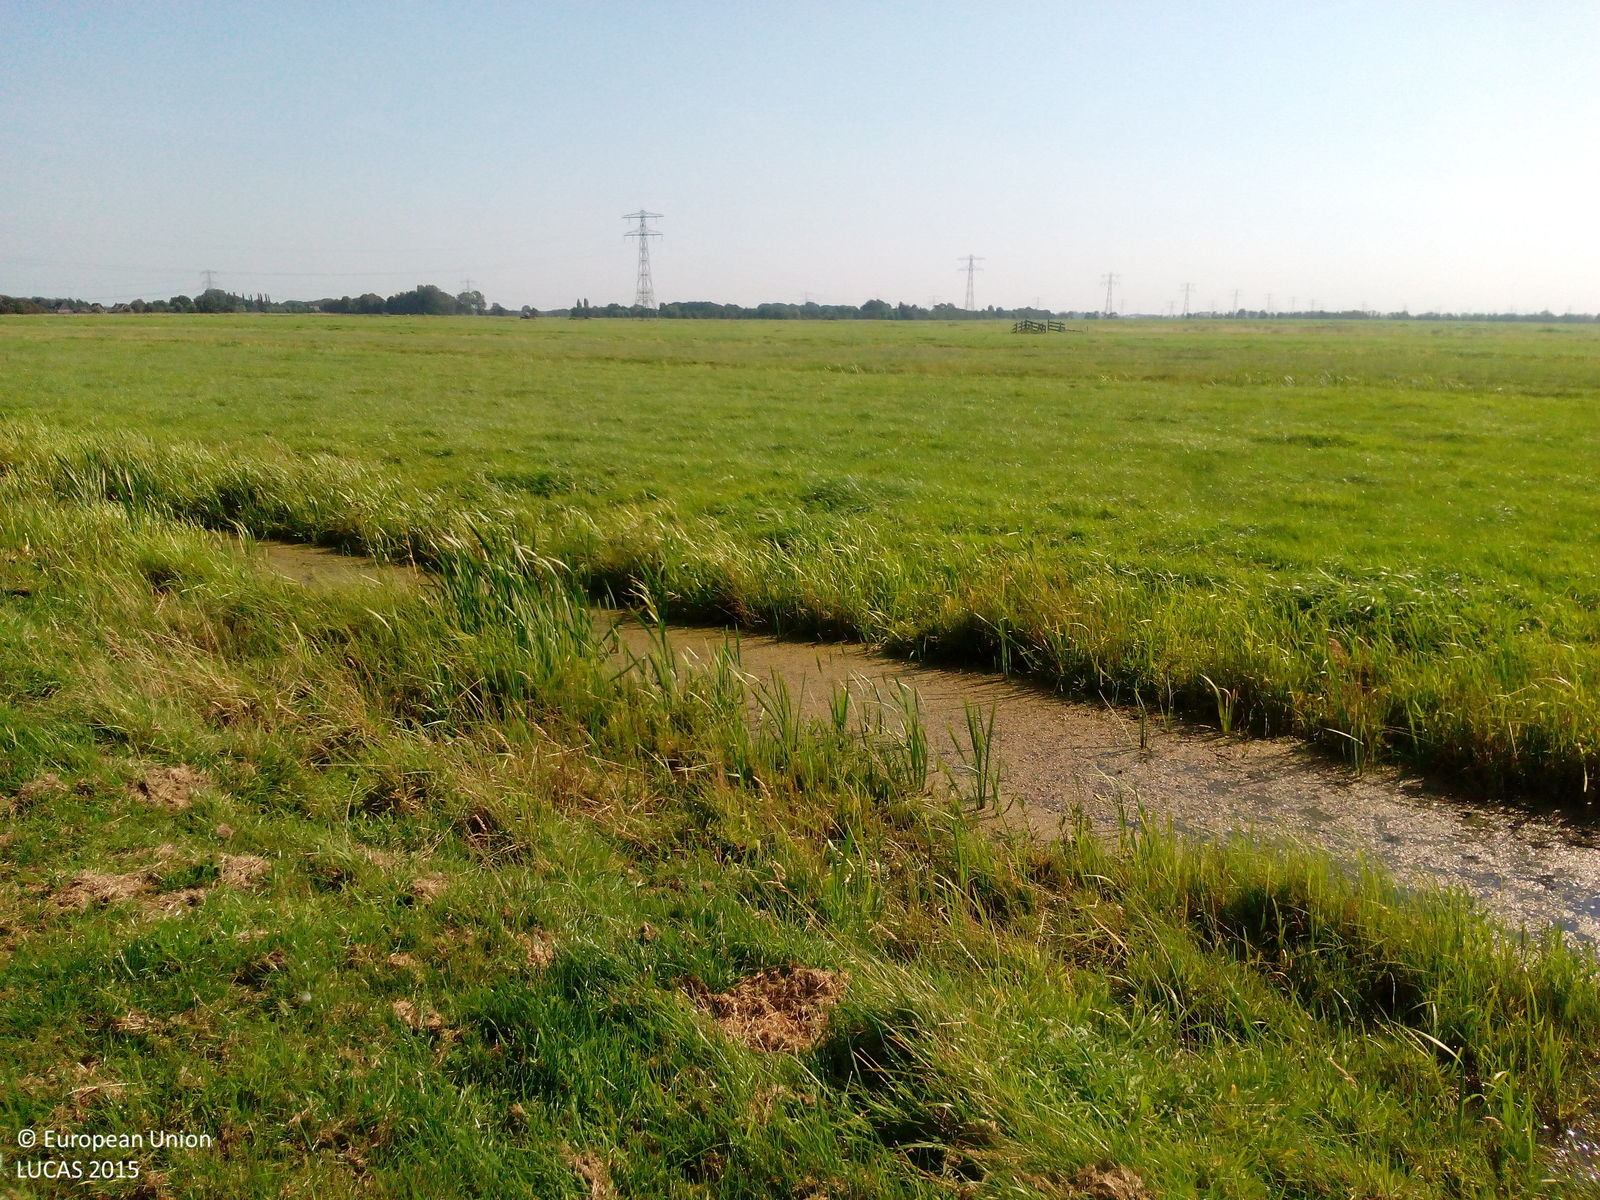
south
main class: Grassland
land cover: Grassland without tree/shrub cover
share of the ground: > 75 %
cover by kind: herbaceous plants 90 %, unconsolidated bare surface 10 %
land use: Agriculture (excluding fallow land and kitchen gardens)
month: August
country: NL
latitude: 51.9702
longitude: 4.6834
